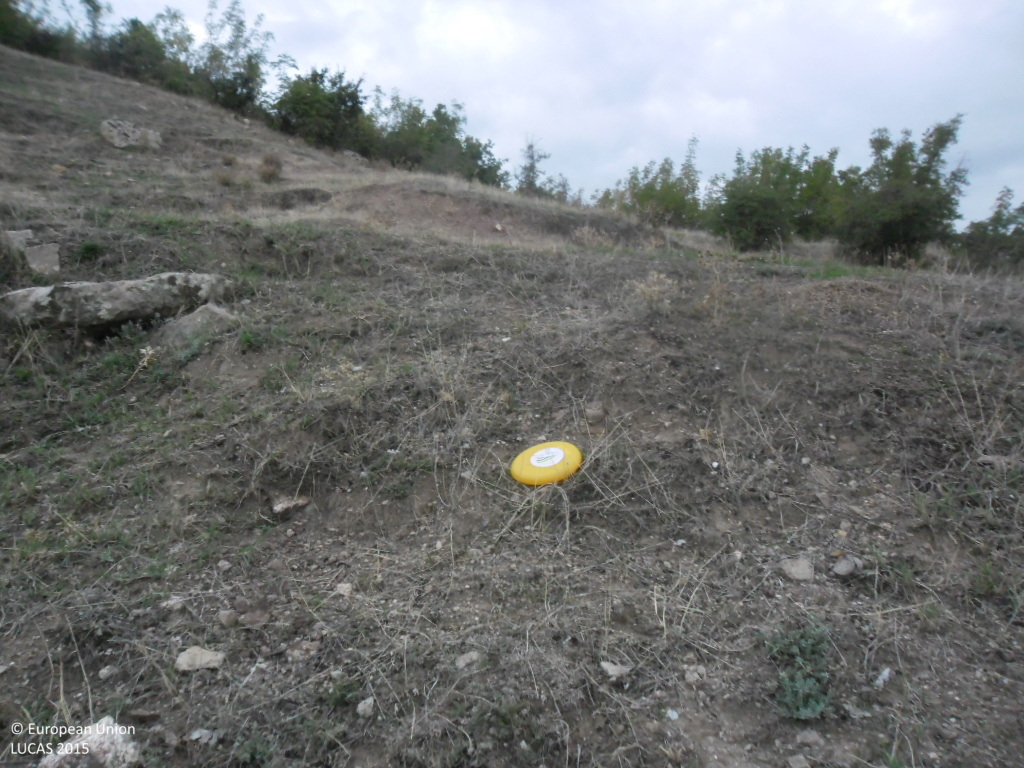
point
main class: Grassland
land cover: Grassland with sparse tree/shrub cover
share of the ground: > 75 %
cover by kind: herbaceous plants 90 %, broadleaved forest trees 5 %, shrubs 5 %
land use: Agriculture (excluding fallow land and kitchen gardens)
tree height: < 5 m
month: September
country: BG
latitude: 41.5844
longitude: 23.2036
